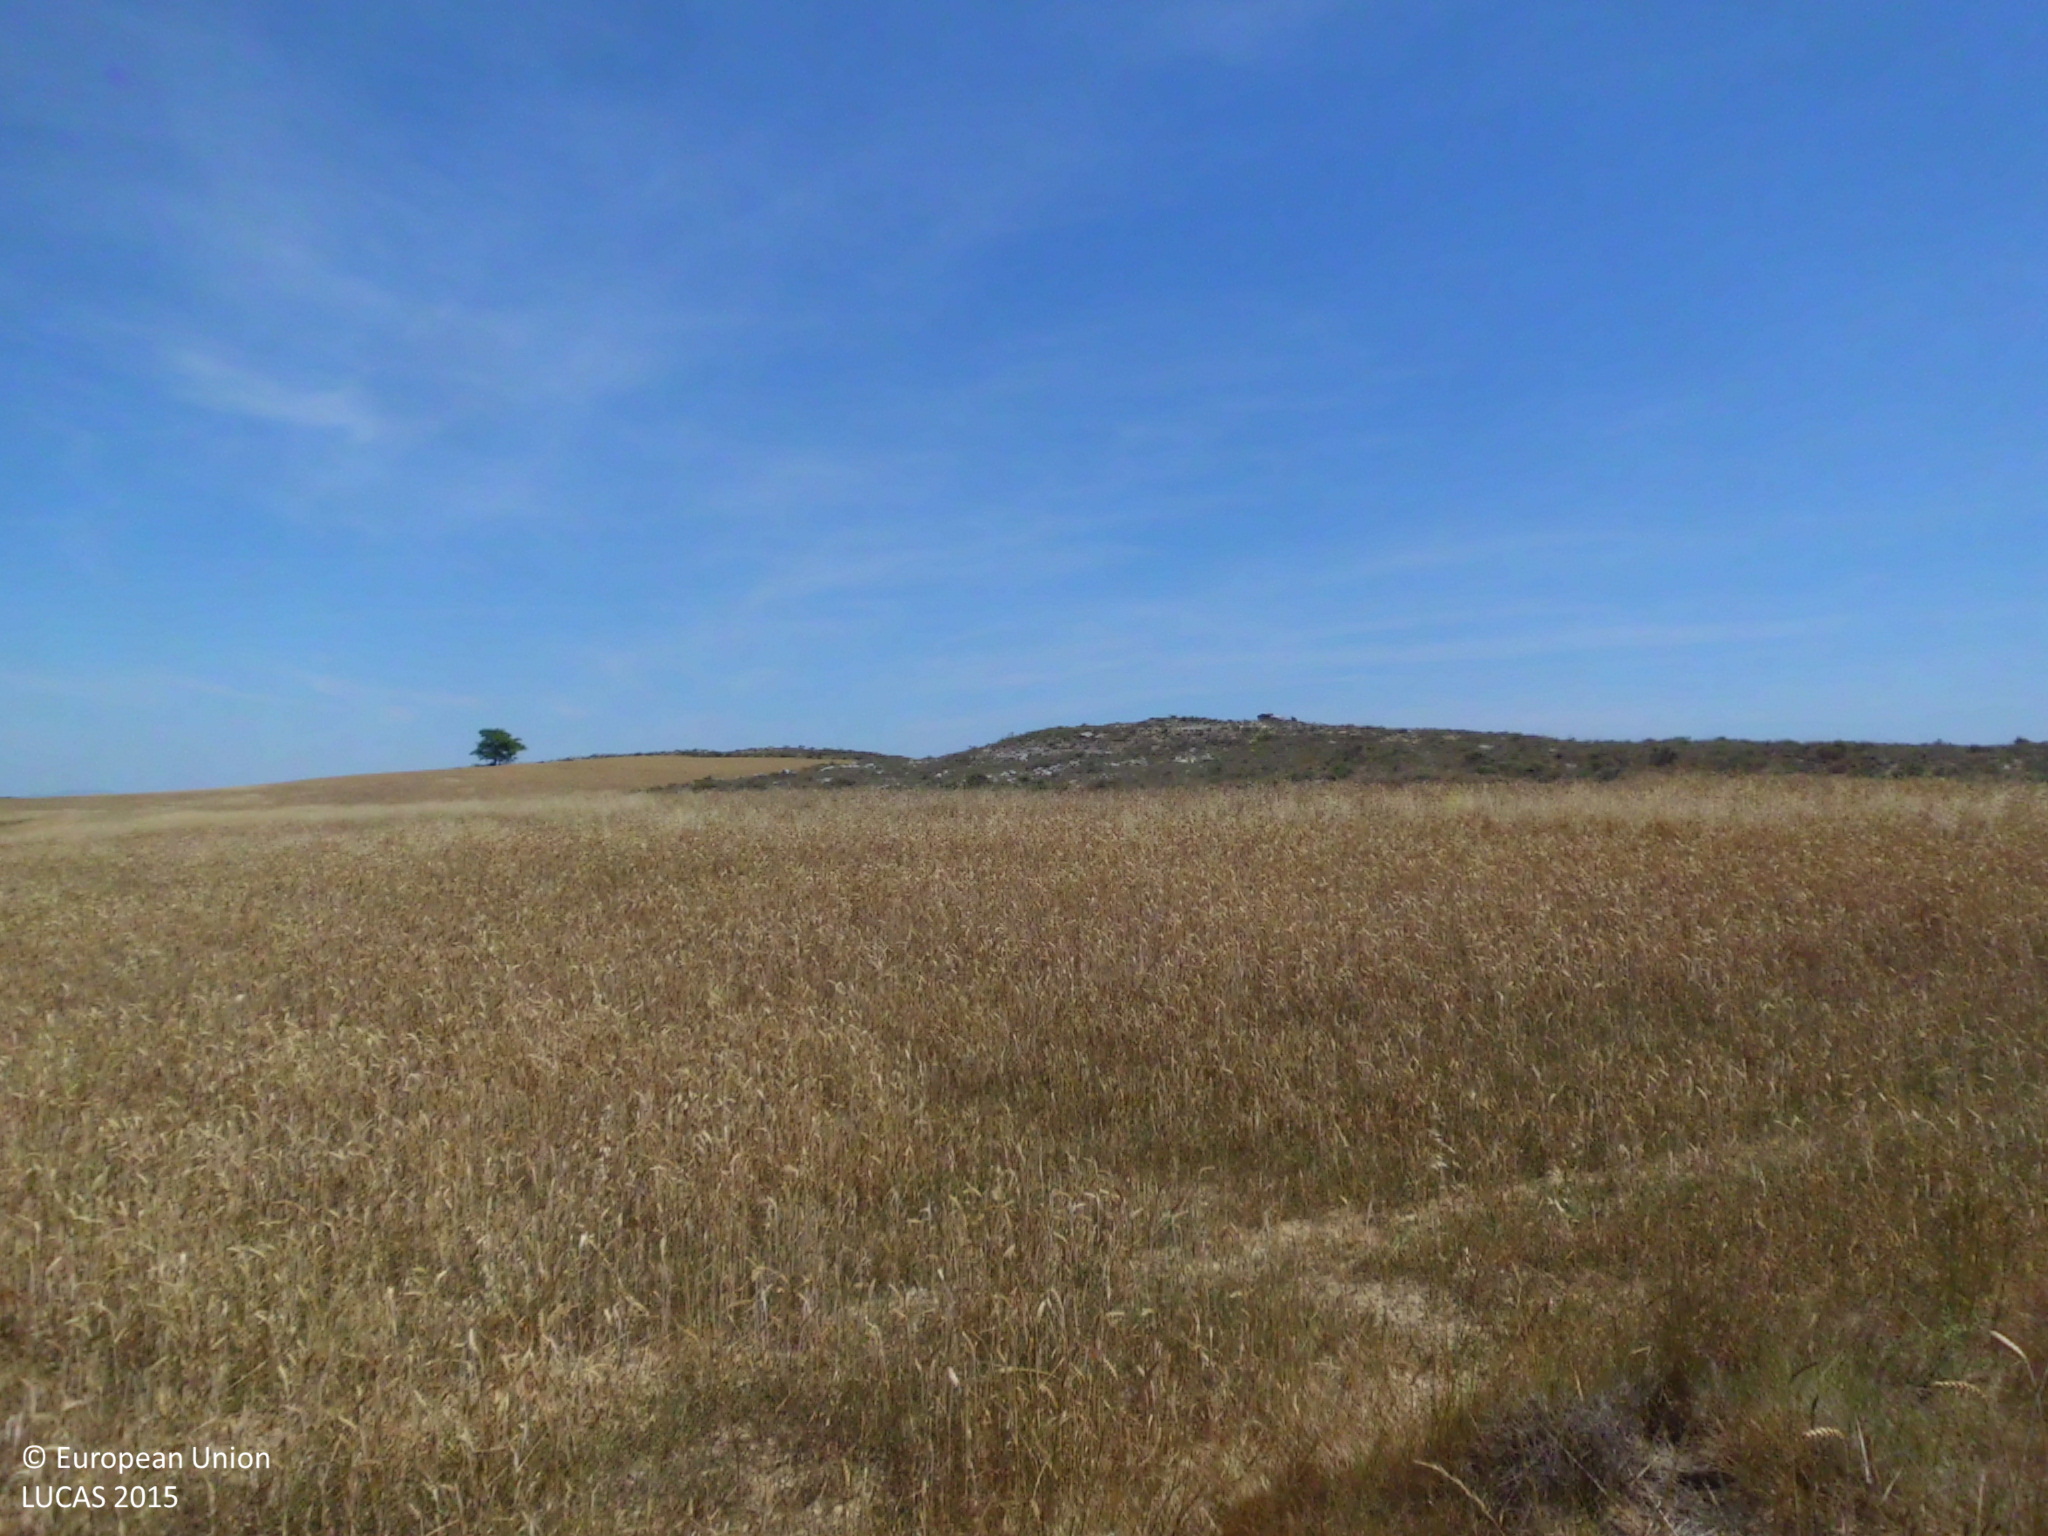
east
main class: Shrubland
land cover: Shrubland without tree cover
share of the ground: 50 - 75 %
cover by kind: shrubs 50 %, unconsolidated bare surface 35 %, herbaceous plants 15 %
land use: Semi-natural and natural areas not in use
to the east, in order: Shrubland without tree cover; Common wheat; Shrubland without tree cover; Common wheat; Shrubland without tree cover
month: July
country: ES
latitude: 42.4848
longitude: -3.3045
